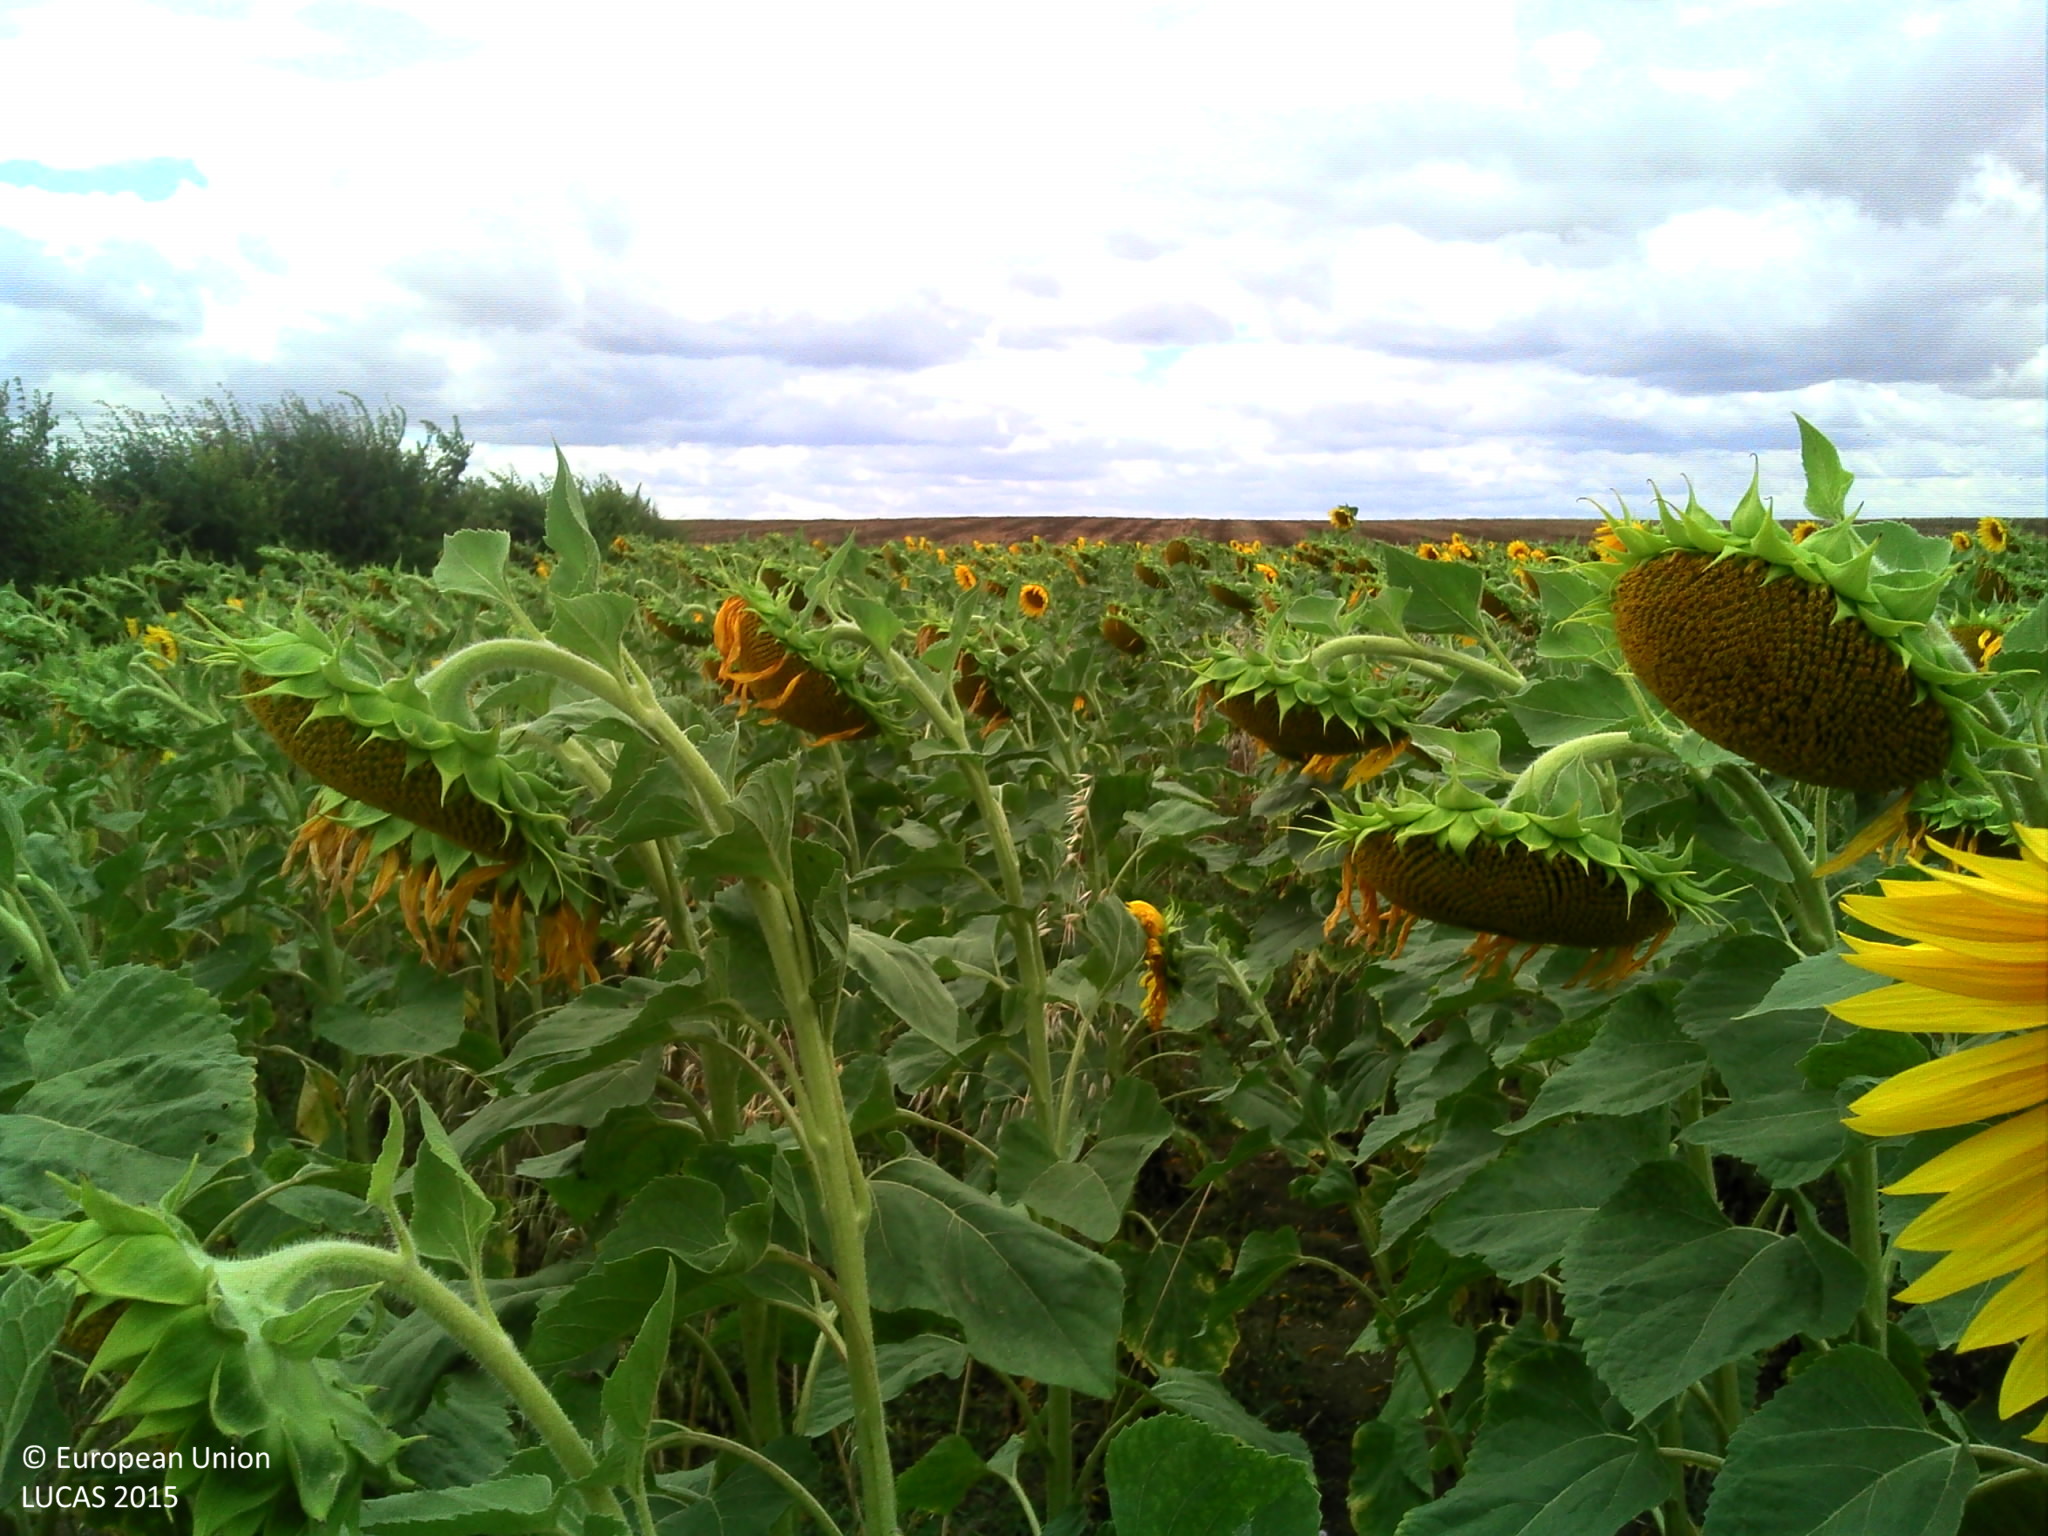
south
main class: Cropland
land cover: Sunflower
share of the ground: > 75 %
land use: Agriculture (excluding fallow land and kitchen gardens)
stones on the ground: < 10 %
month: July
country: FR
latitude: 46.7952
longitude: 2.2764
